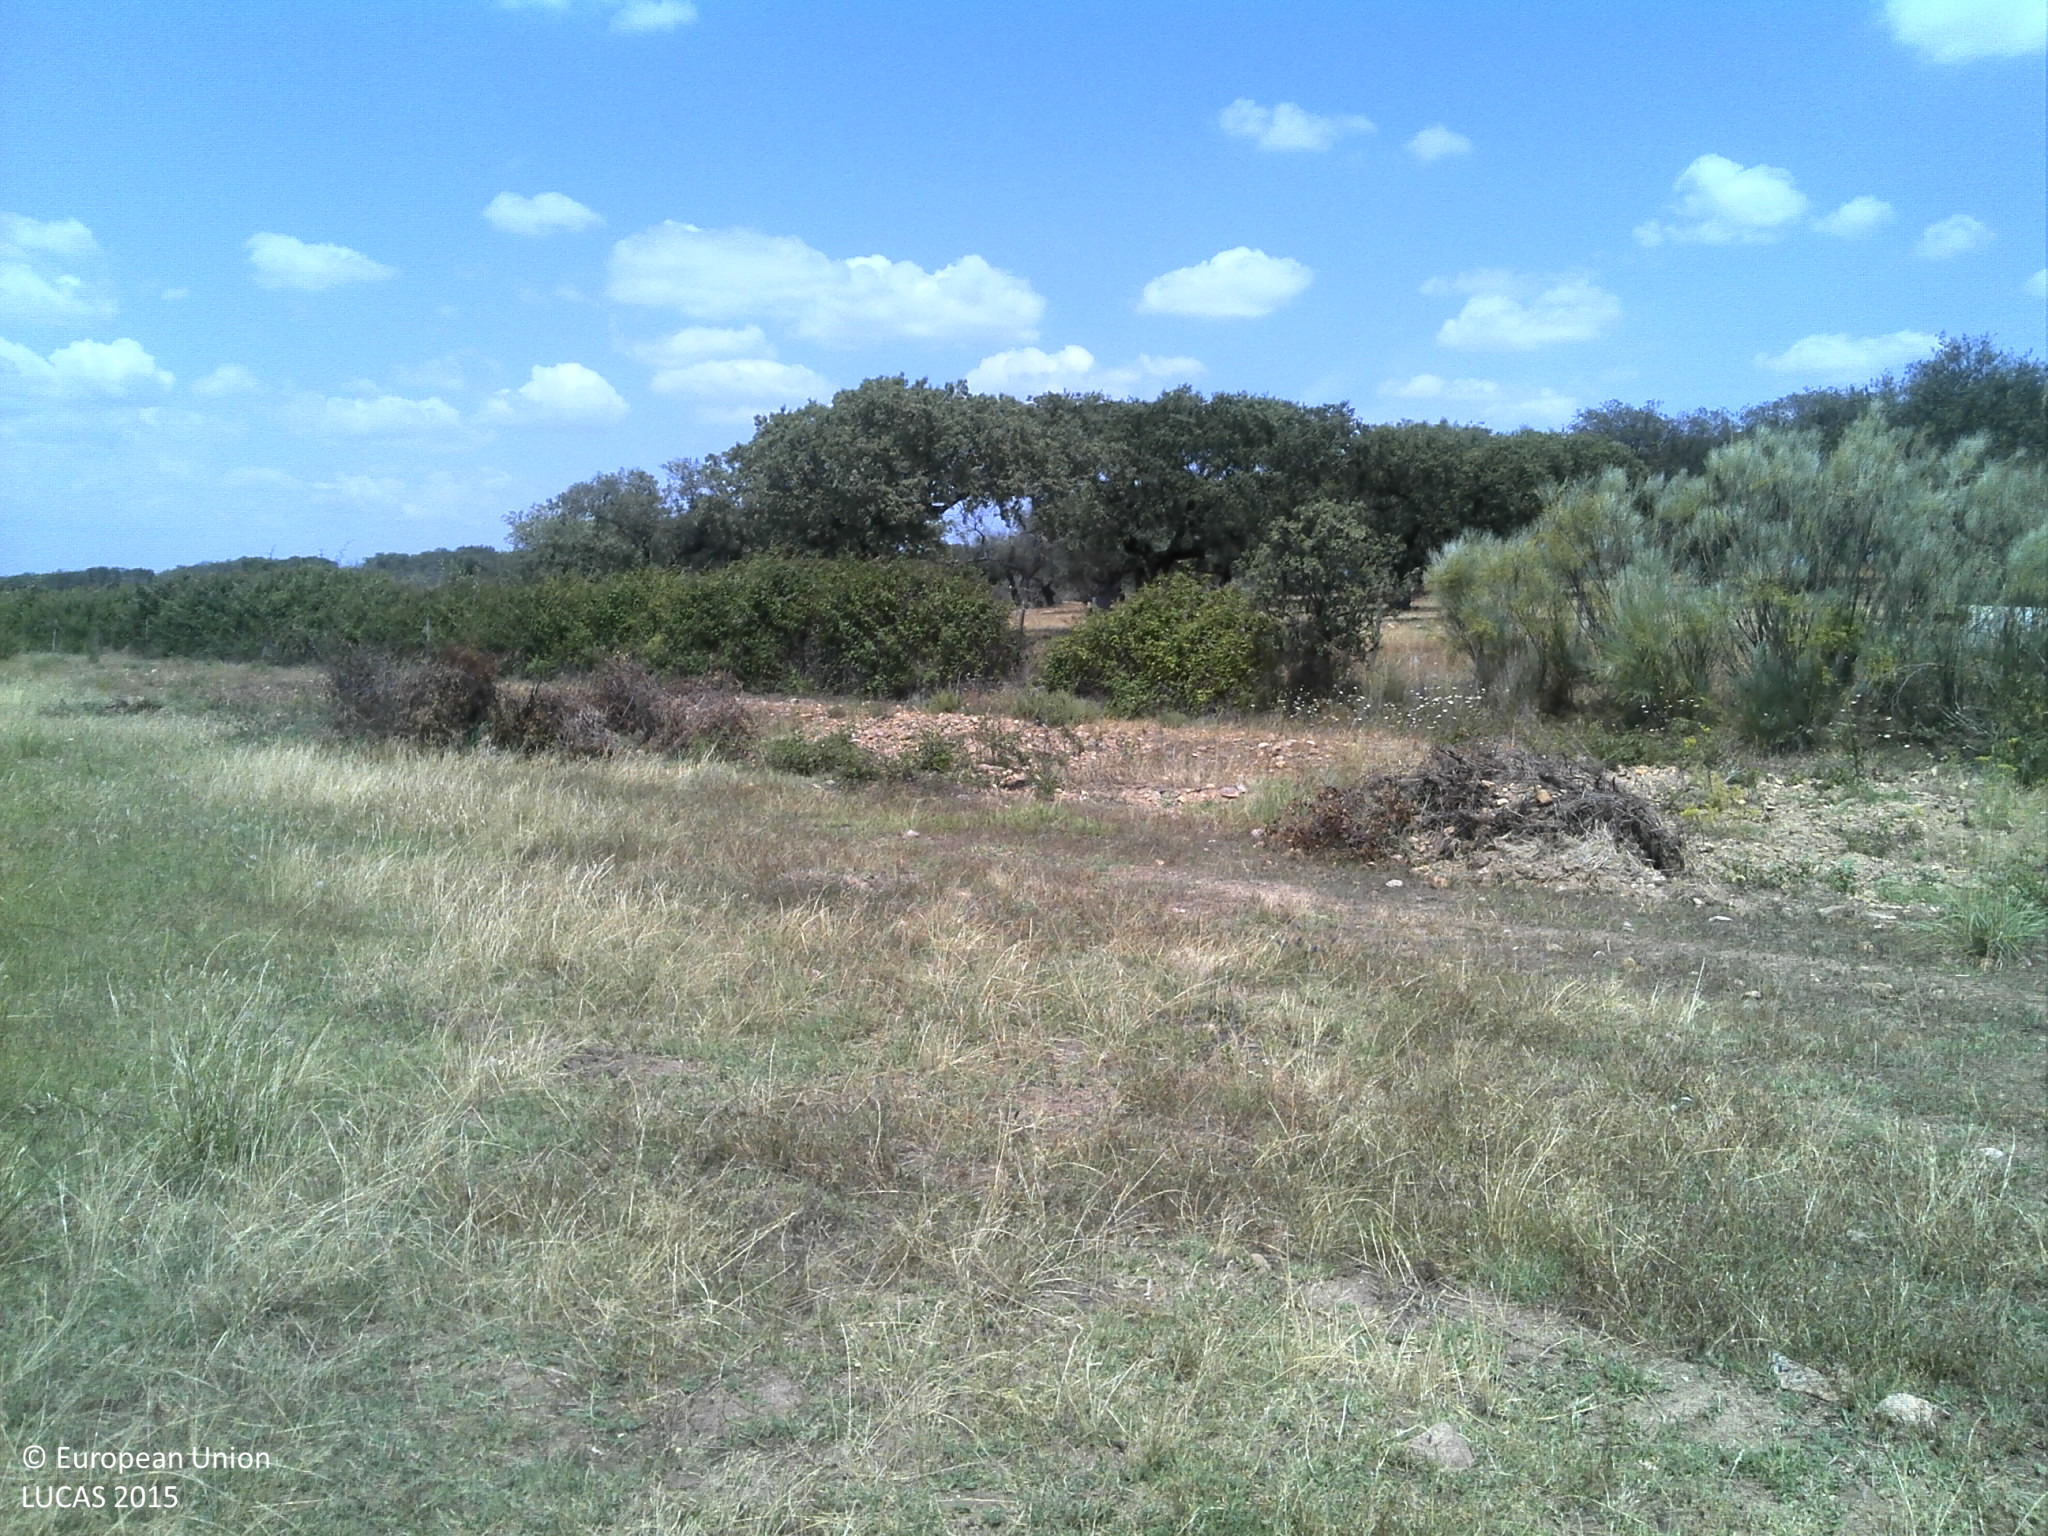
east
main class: Grassland
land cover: Grassland without tree/shrub cover
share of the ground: 50 - 75 %
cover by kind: herbaceous plants 50 %, unconsolidated bare surface 40 %, shrubs 5 %
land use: Agriculture (excluding fallow land and kitchen gardens)
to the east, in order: Grassland without tree/shrub cover; Grass margins; Ditches and canals; Grass margins; Fences; Broadleaved woodland
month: June
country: PT
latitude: 39.8739
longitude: -7.1261
